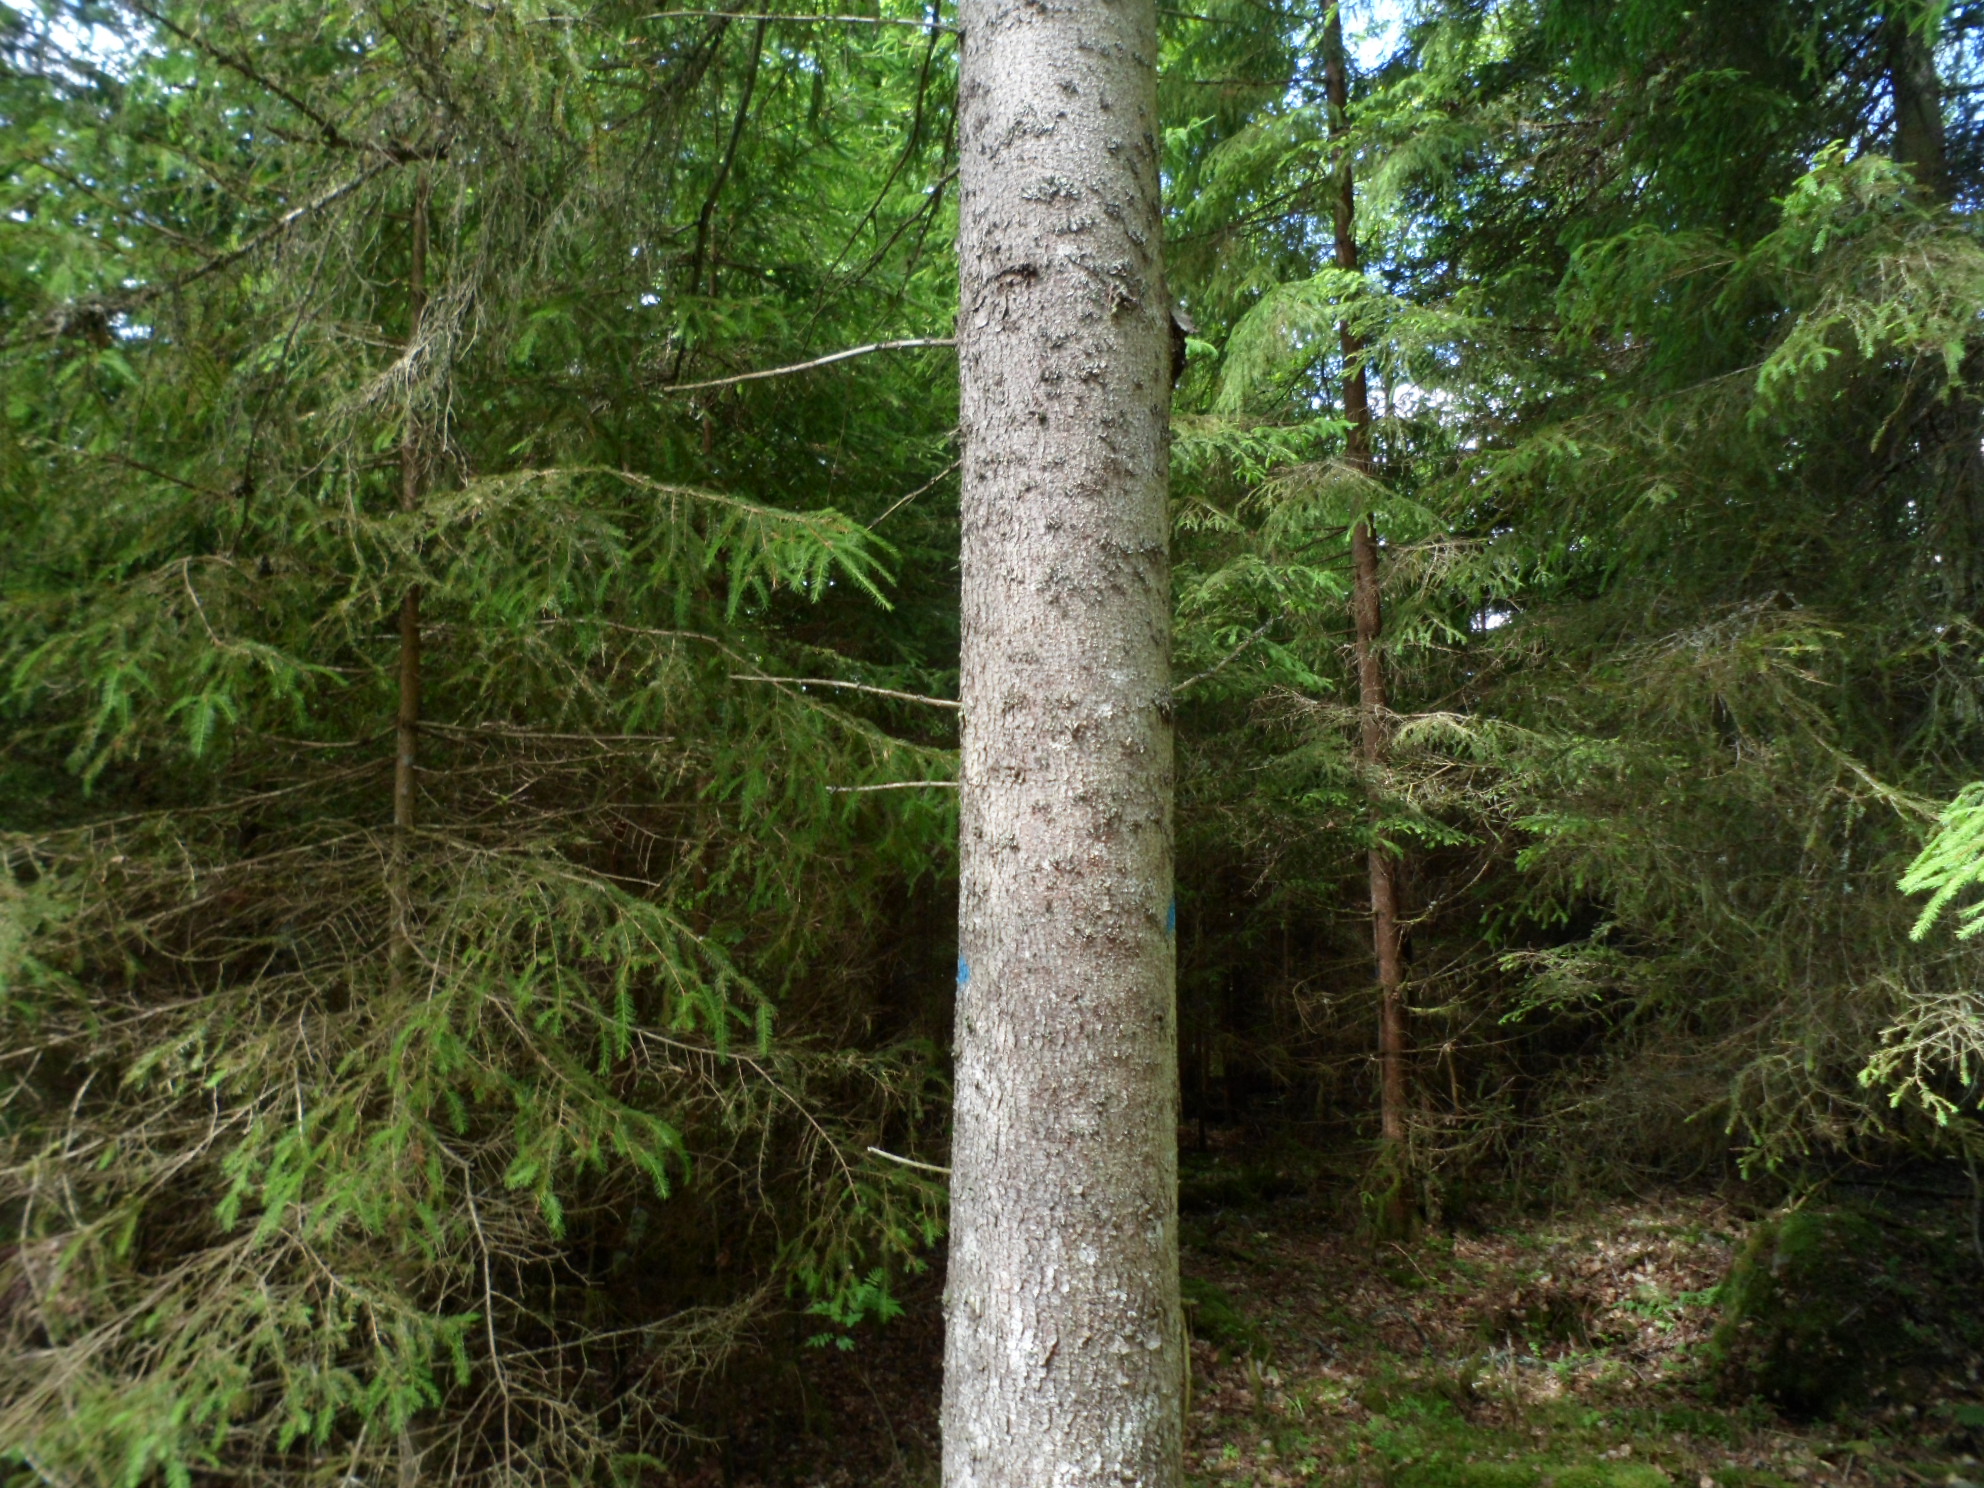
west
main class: Woodland
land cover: Spruce dominated mixed woodland
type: boreal forest
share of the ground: 50 - 75 %
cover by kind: coniferous forest trees 45 %, broadleaved forest trees 30 %, lichens and mosses 10 %, shrubs 5 %, herbaceous plants 5 %, unconsolidated bare surface 5 %
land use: Forestry
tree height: > 5 m
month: June
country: SE
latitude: 57.0869
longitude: 14.3362
